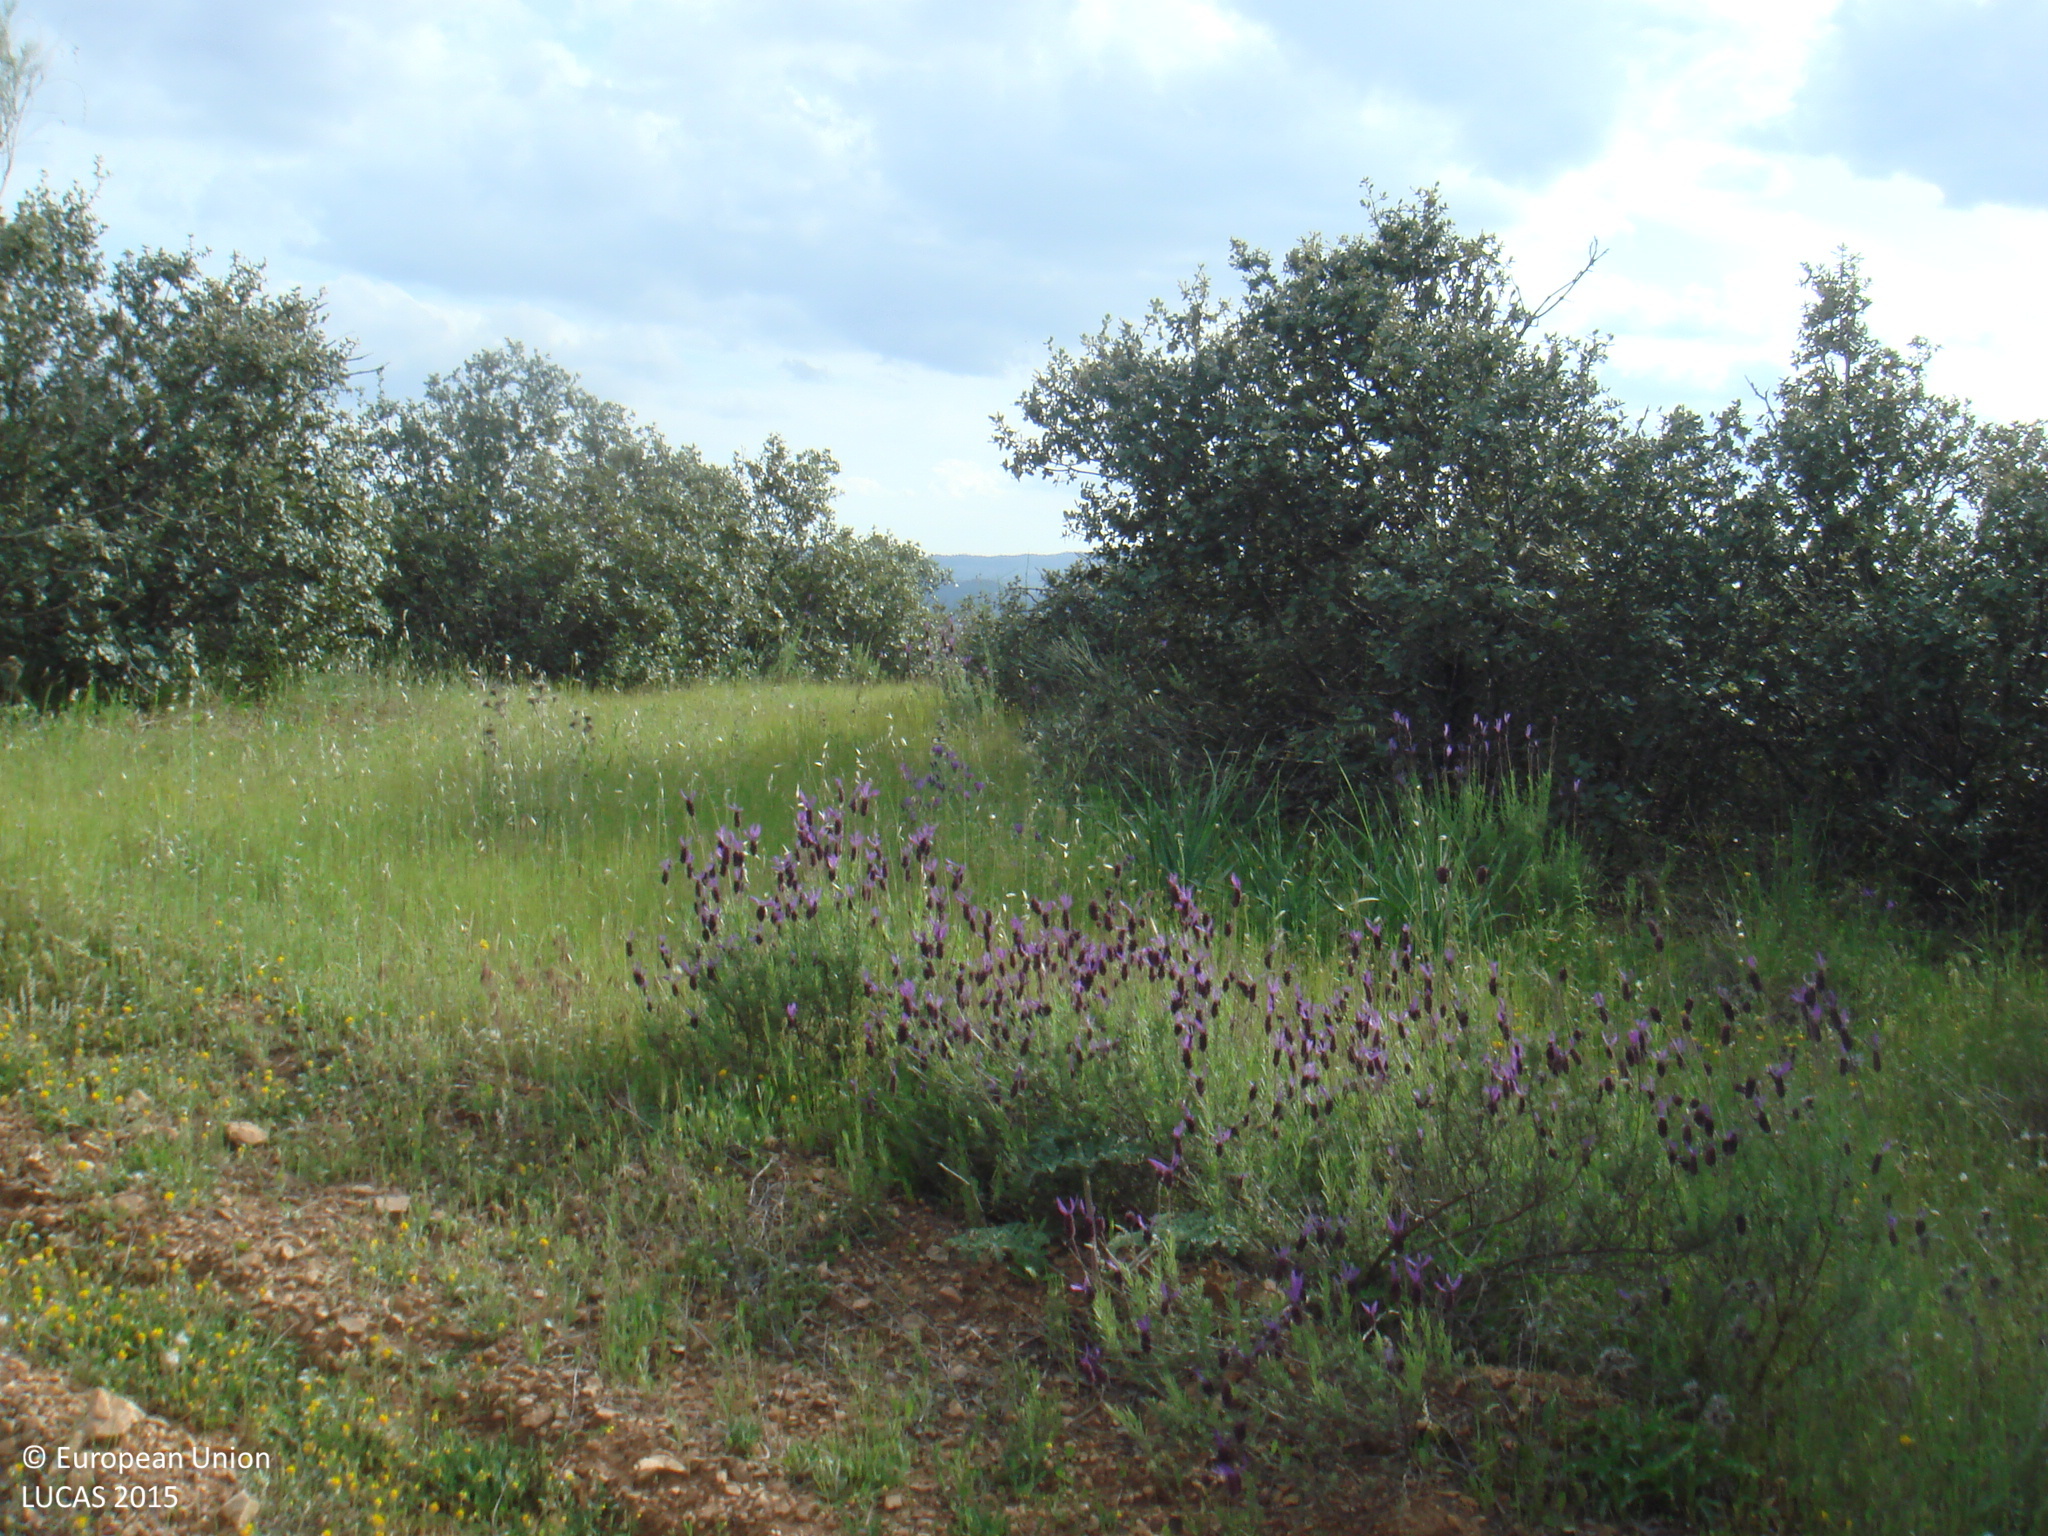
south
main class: Grassland
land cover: Grassland with sparse tree/shrub cover
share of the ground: > 75 %
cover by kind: herbaceous plants 50 %, unconsolidated bare surface 45 %, broadleaved forest trees 5 %
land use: Agriculture (excluding fallow land and kitchen gardens)
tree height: > 5 m
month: April
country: ES
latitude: 38.1894
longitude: -4.9907
